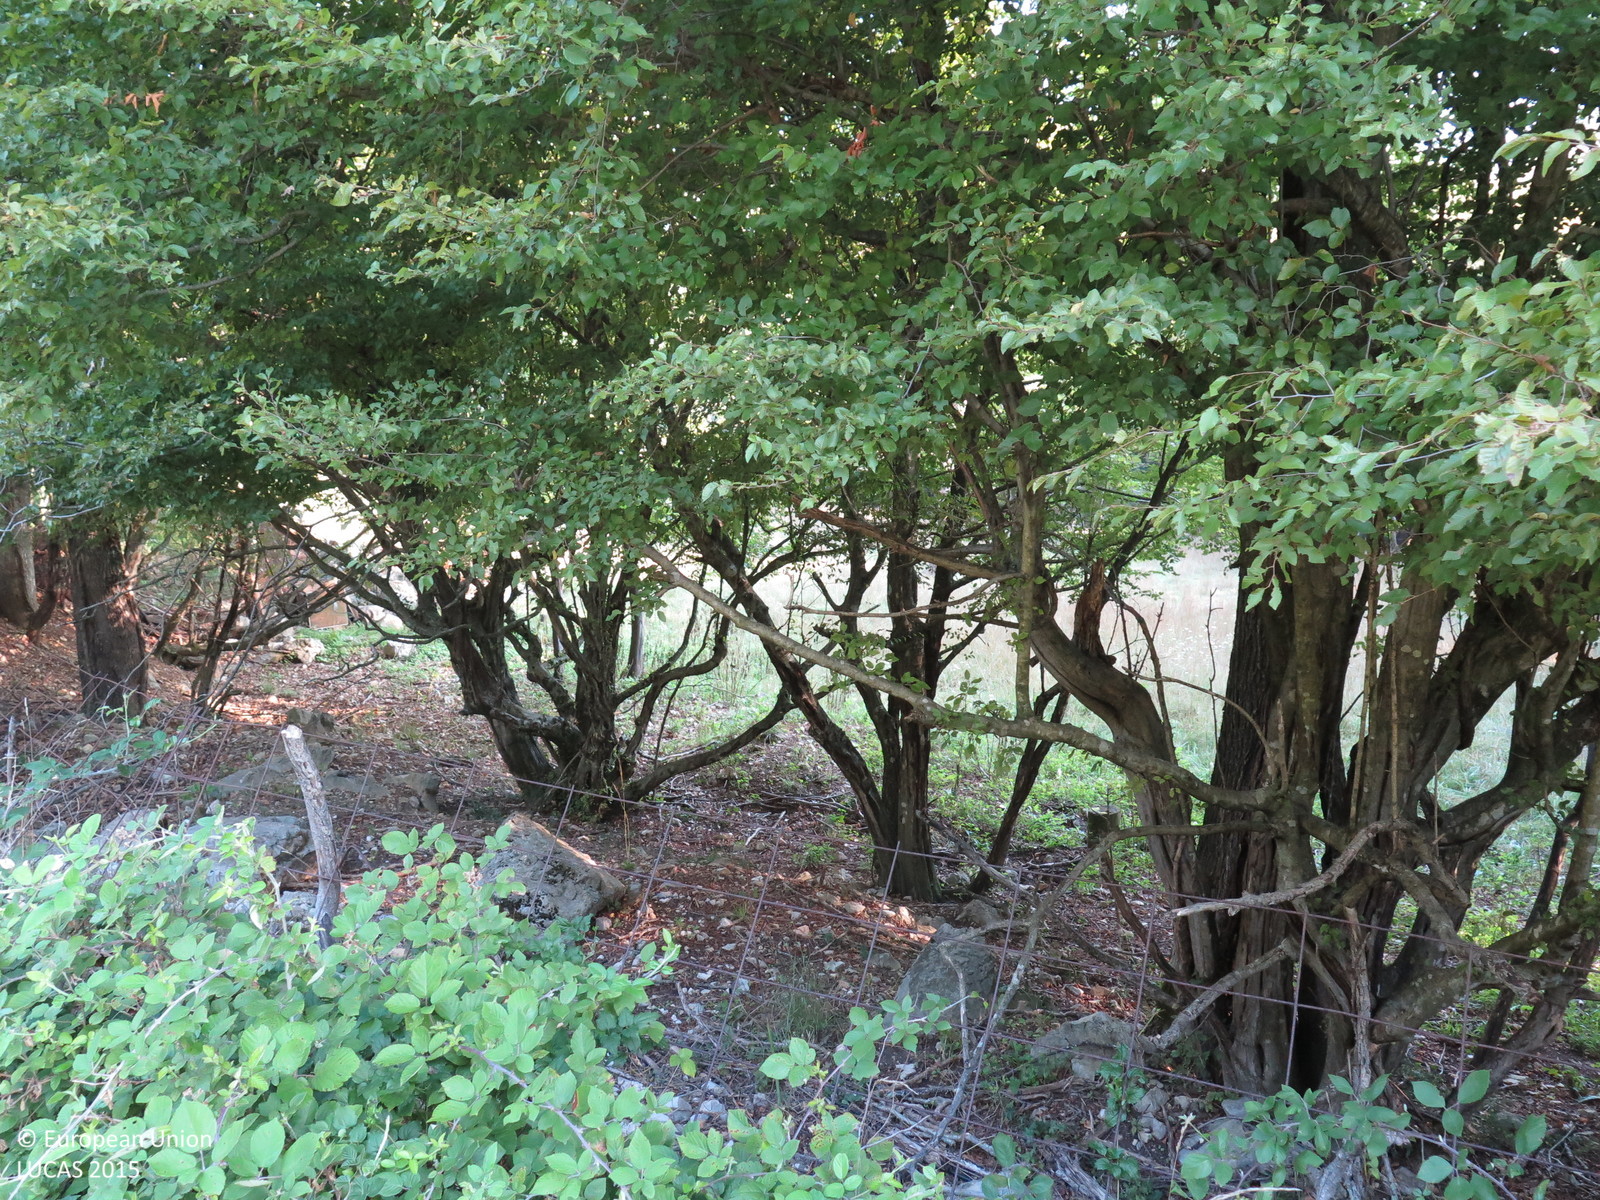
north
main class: Shrubland
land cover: Shrubland with sparse tree cover
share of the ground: > 75 %
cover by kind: shrubs 90 %, broadleaved forest trees 5 %, herbaceous plants 5 %
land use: Semi-natural and natural areas not in use
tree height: < 5 m
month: August
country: HR
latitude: 45.2015
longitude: 14.6923
